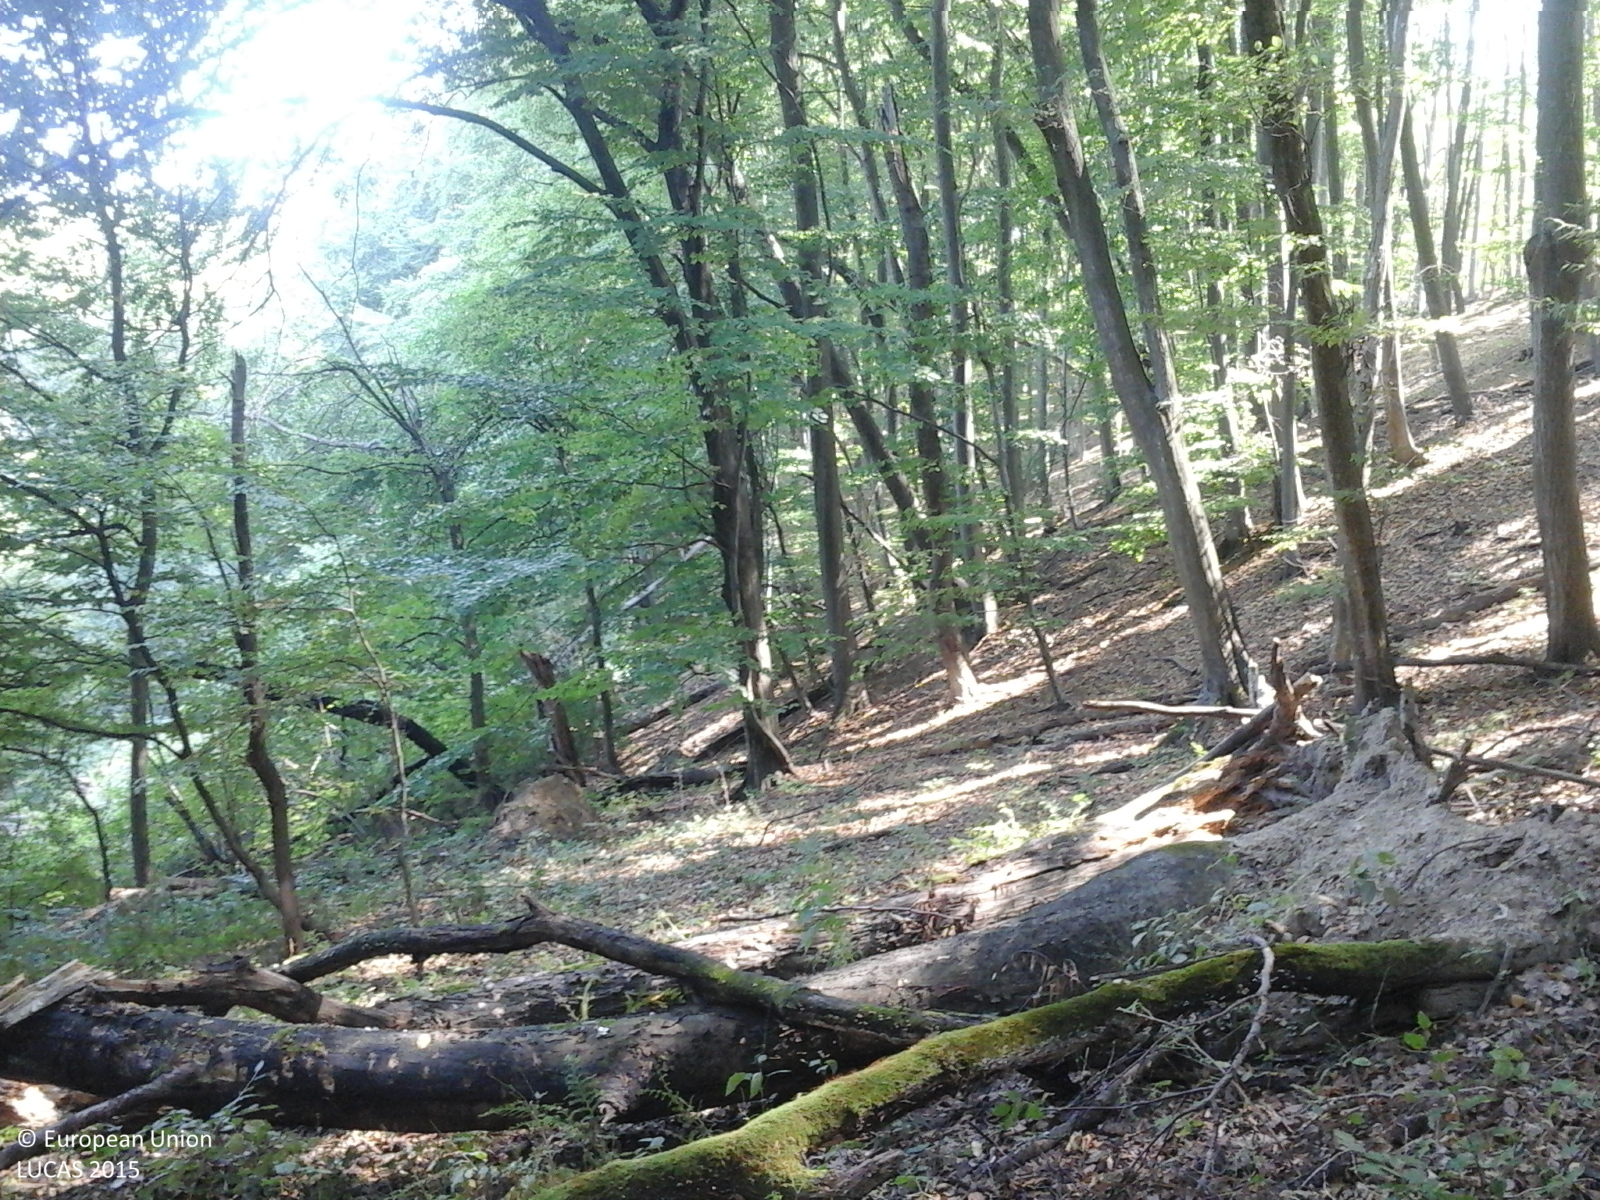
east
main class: Woodland
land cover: Broadleaved woodland
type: beech forest
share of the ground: > 75 %
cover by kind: broadleaved forest trees 100 %
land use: Forestry
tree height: > 5 m
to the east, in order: Broadleaved woodland
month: August
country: RO
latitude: 45.9010
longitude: 22.6954
